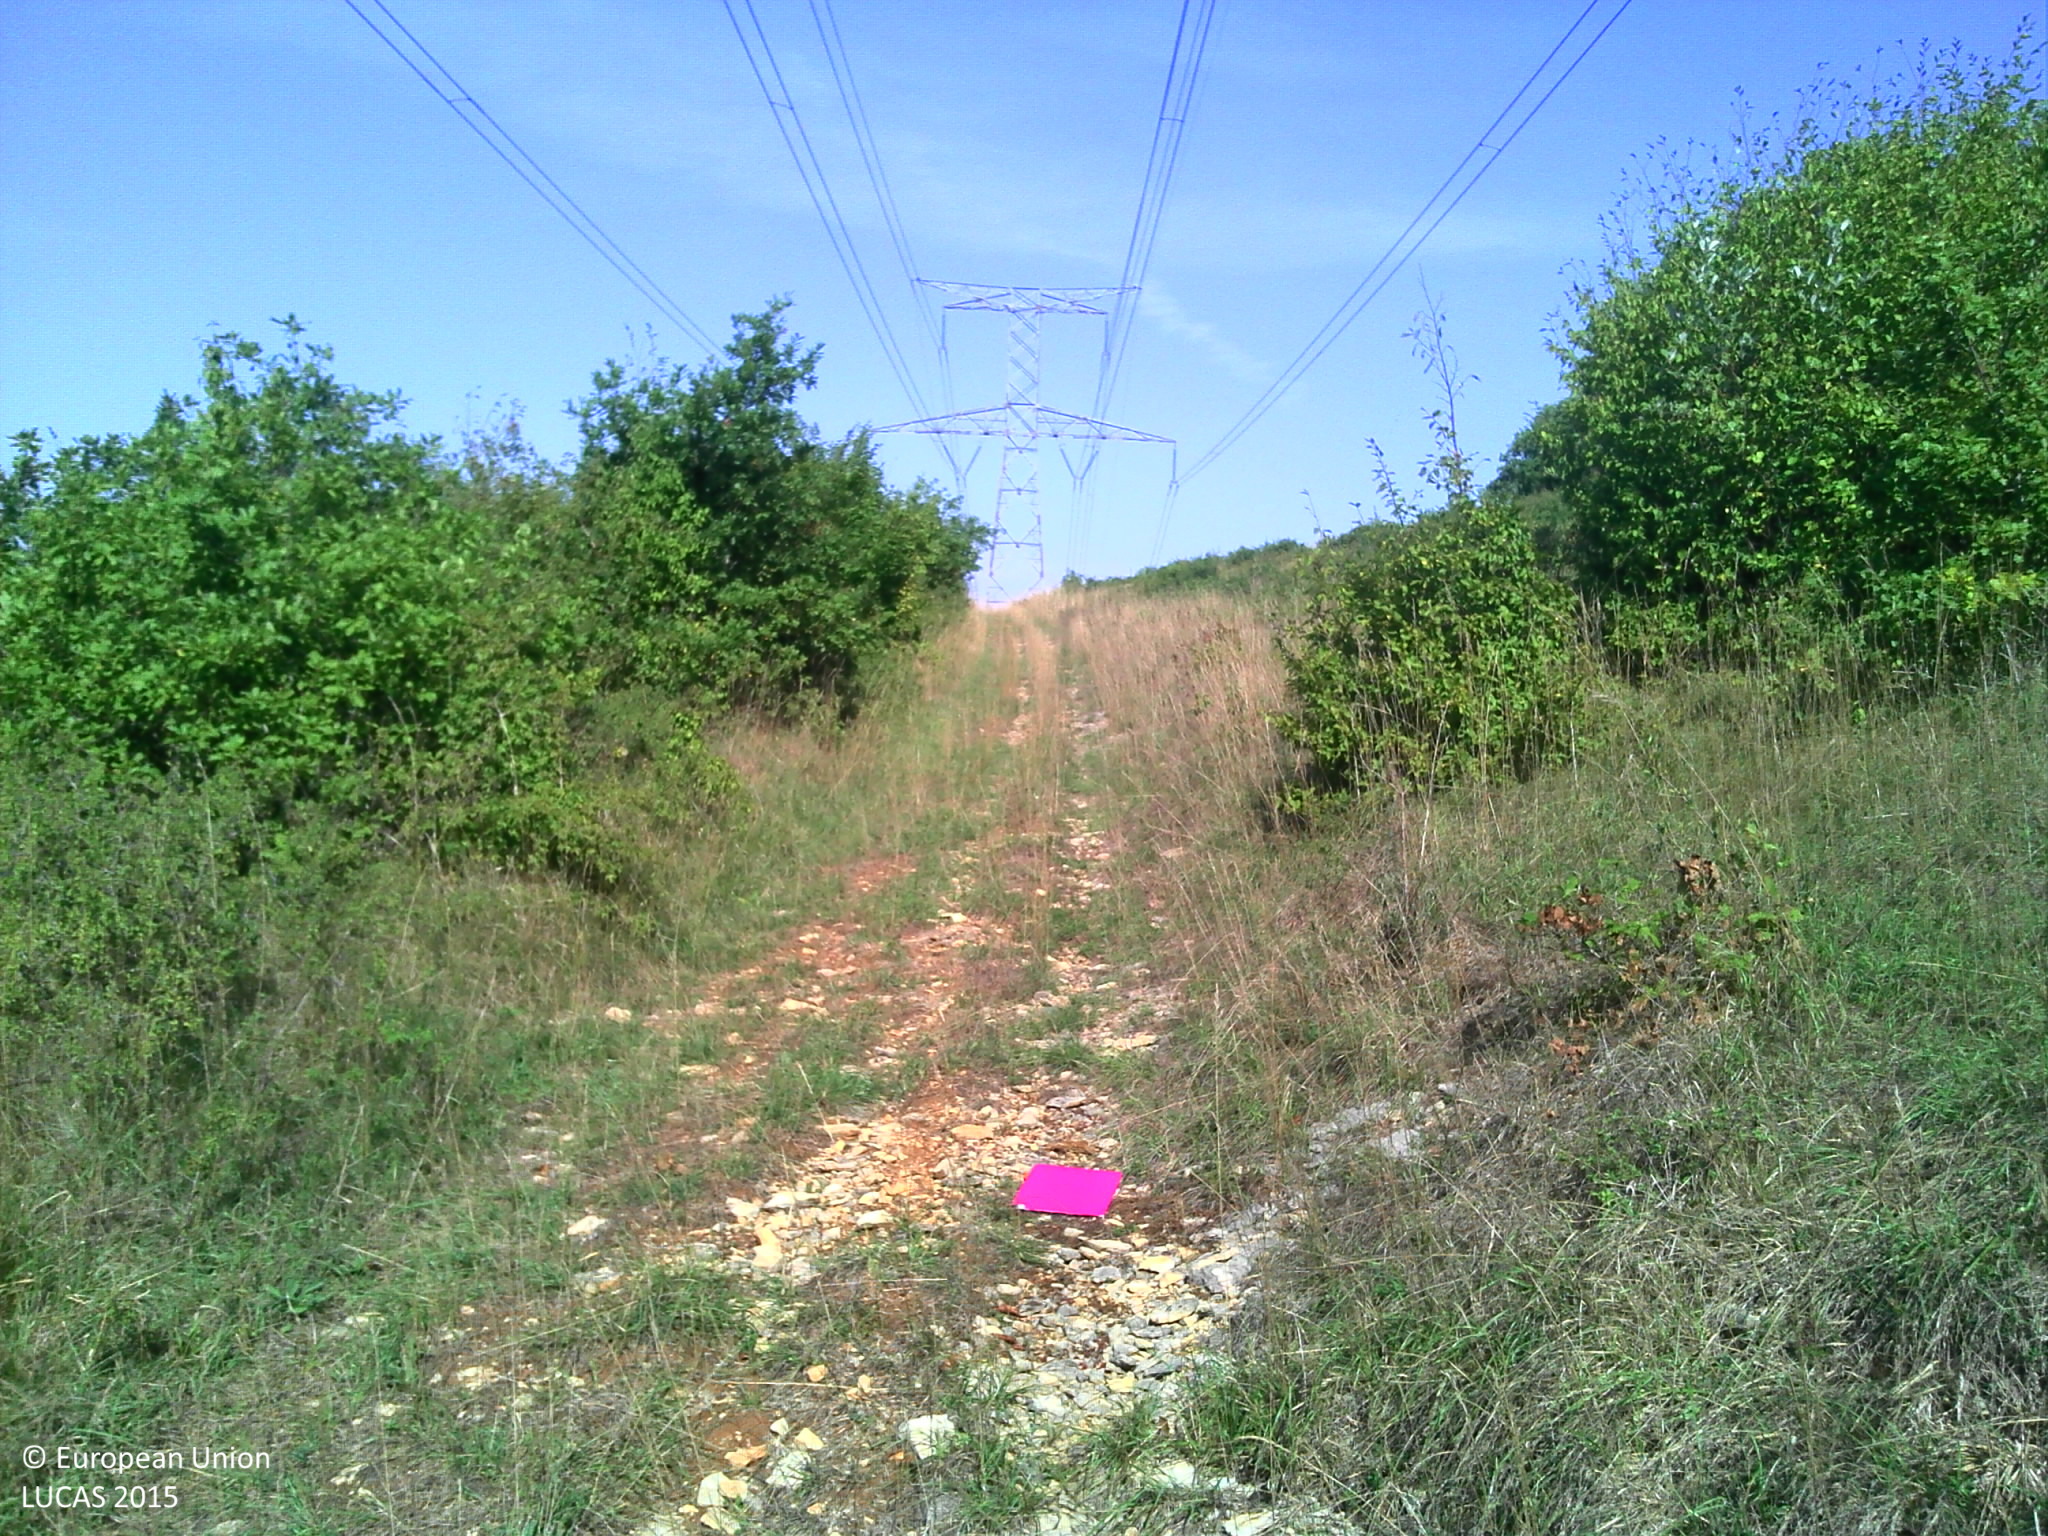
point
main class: Woodland
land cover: Broadleaved woodland
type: mesophytic deciduous forest
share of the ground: > 75 %
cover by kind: broadleaved forest trees 70 %, herbaceous plants 20 %, shrubs 10 %
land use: Semi-natural and natural areas not in use
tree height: < 5 m
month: August
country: FR
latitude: 47.2369
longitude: 4.8354
